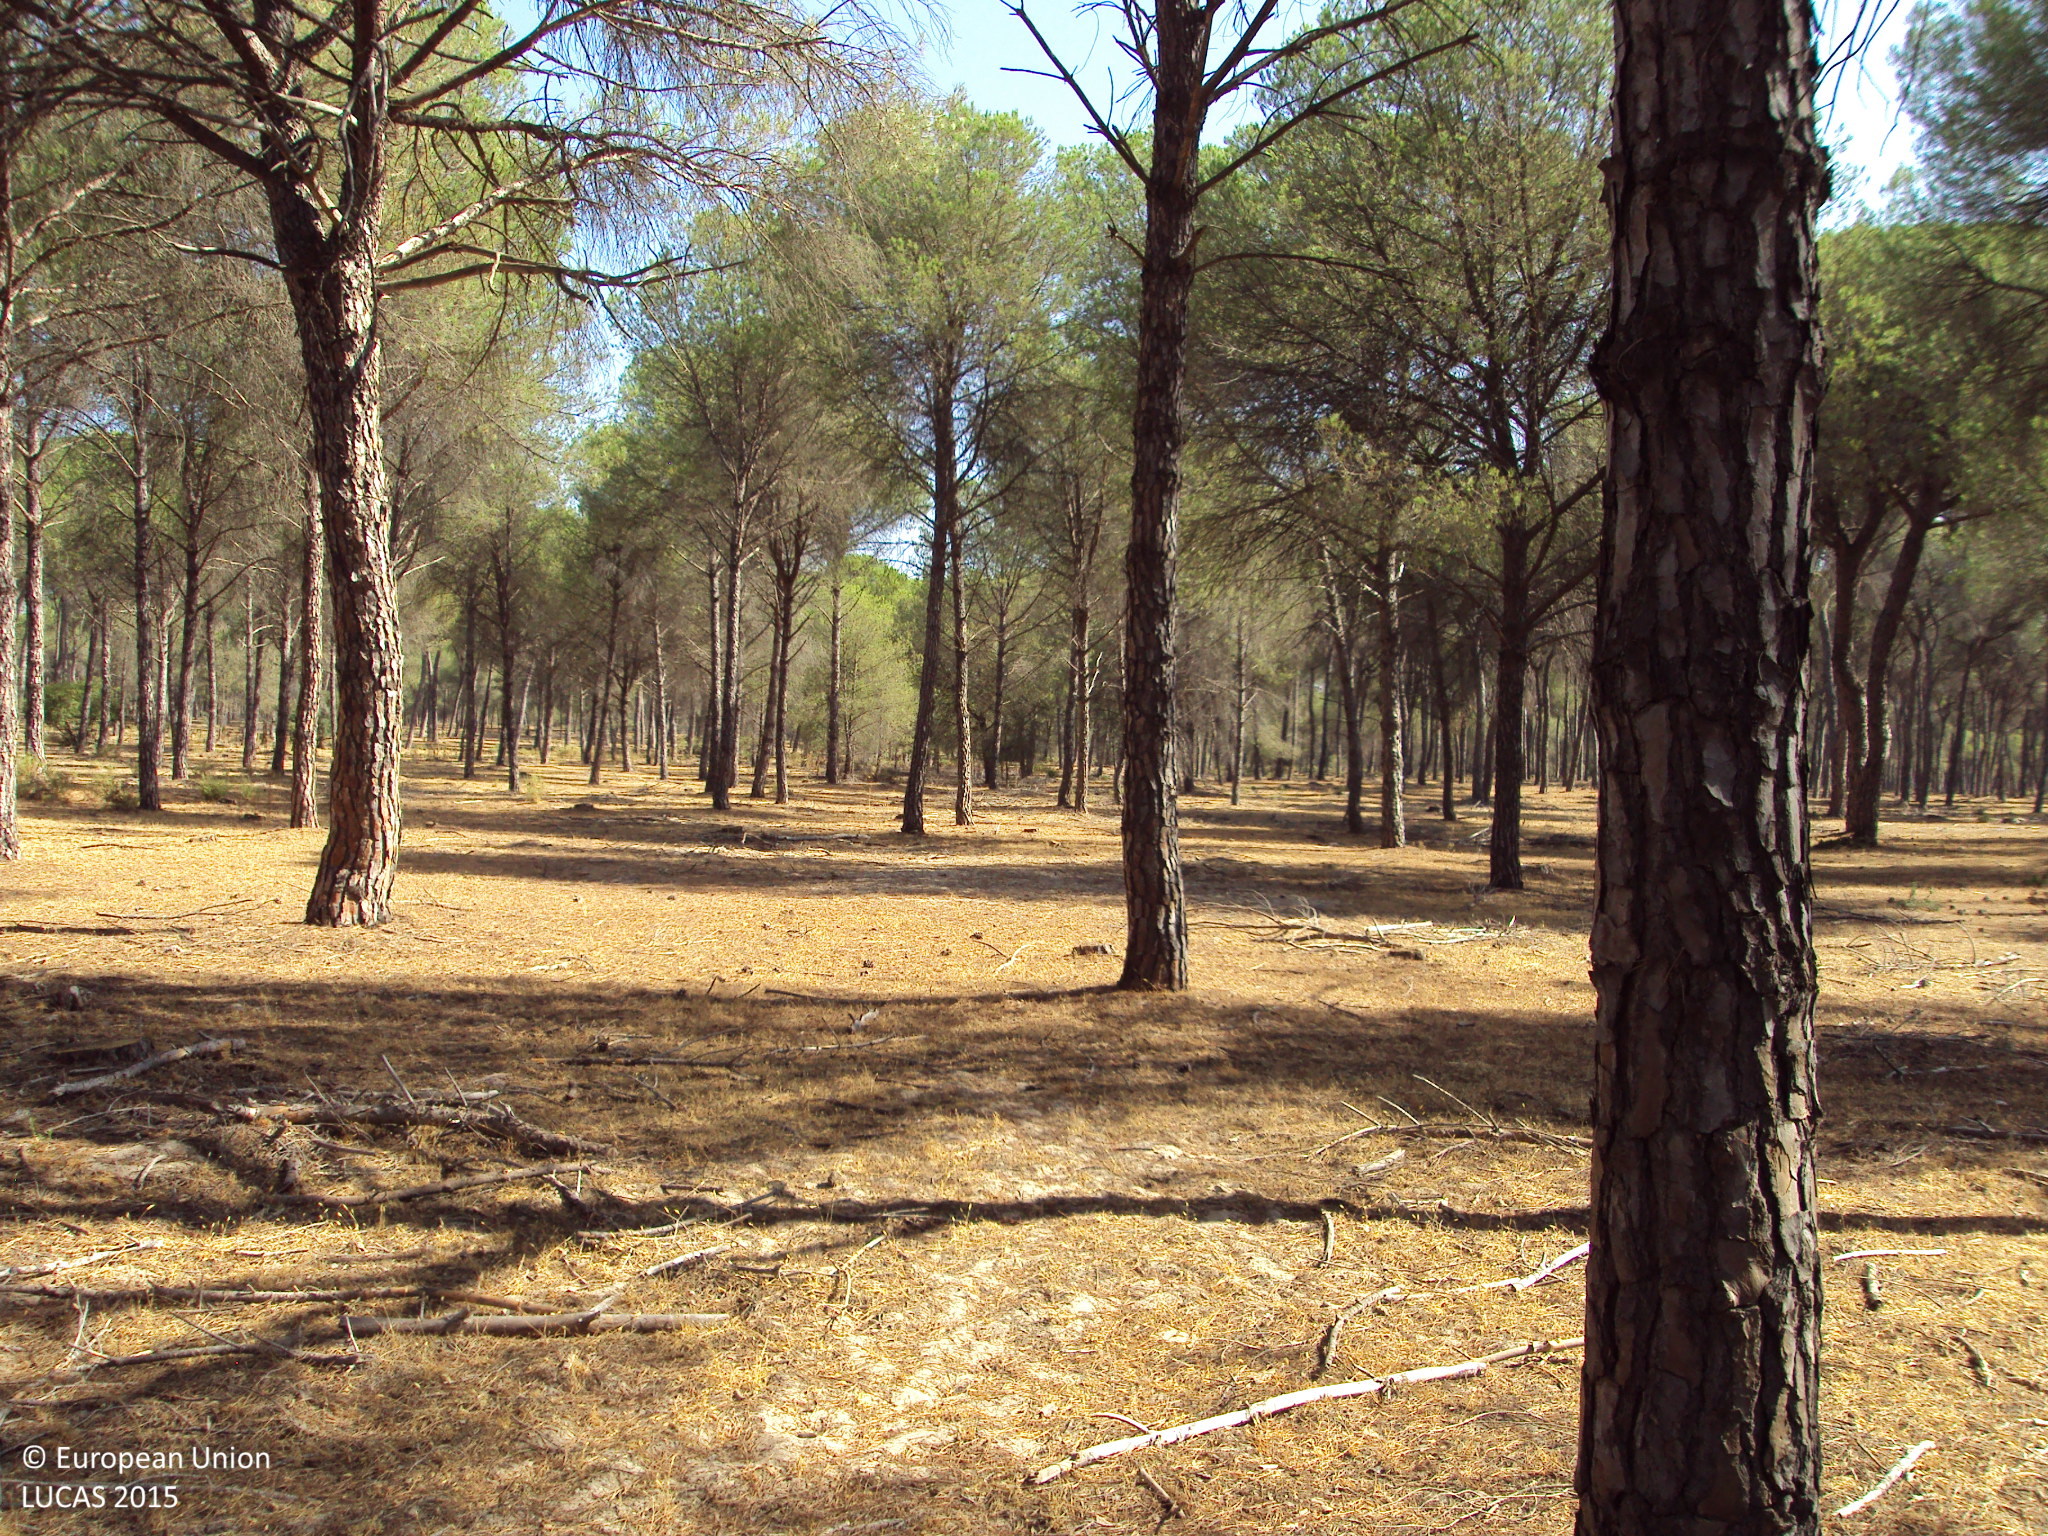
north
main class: Woodland
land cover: Pine dominated coniferous woodland
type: coniferous forest of the mediterranean region
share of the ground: > 75 %
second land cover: Spontaneously vegetated surfaces
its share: 25 - 50 %
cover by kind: coniferous forest trees 95 %, herbaceous plants 5 %
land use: Forestry
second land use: Agriculture (excluding fallow land and kitchen gardens)
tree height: > 5 m
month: August
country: ES
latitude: 37.1680
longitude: -6.3667
